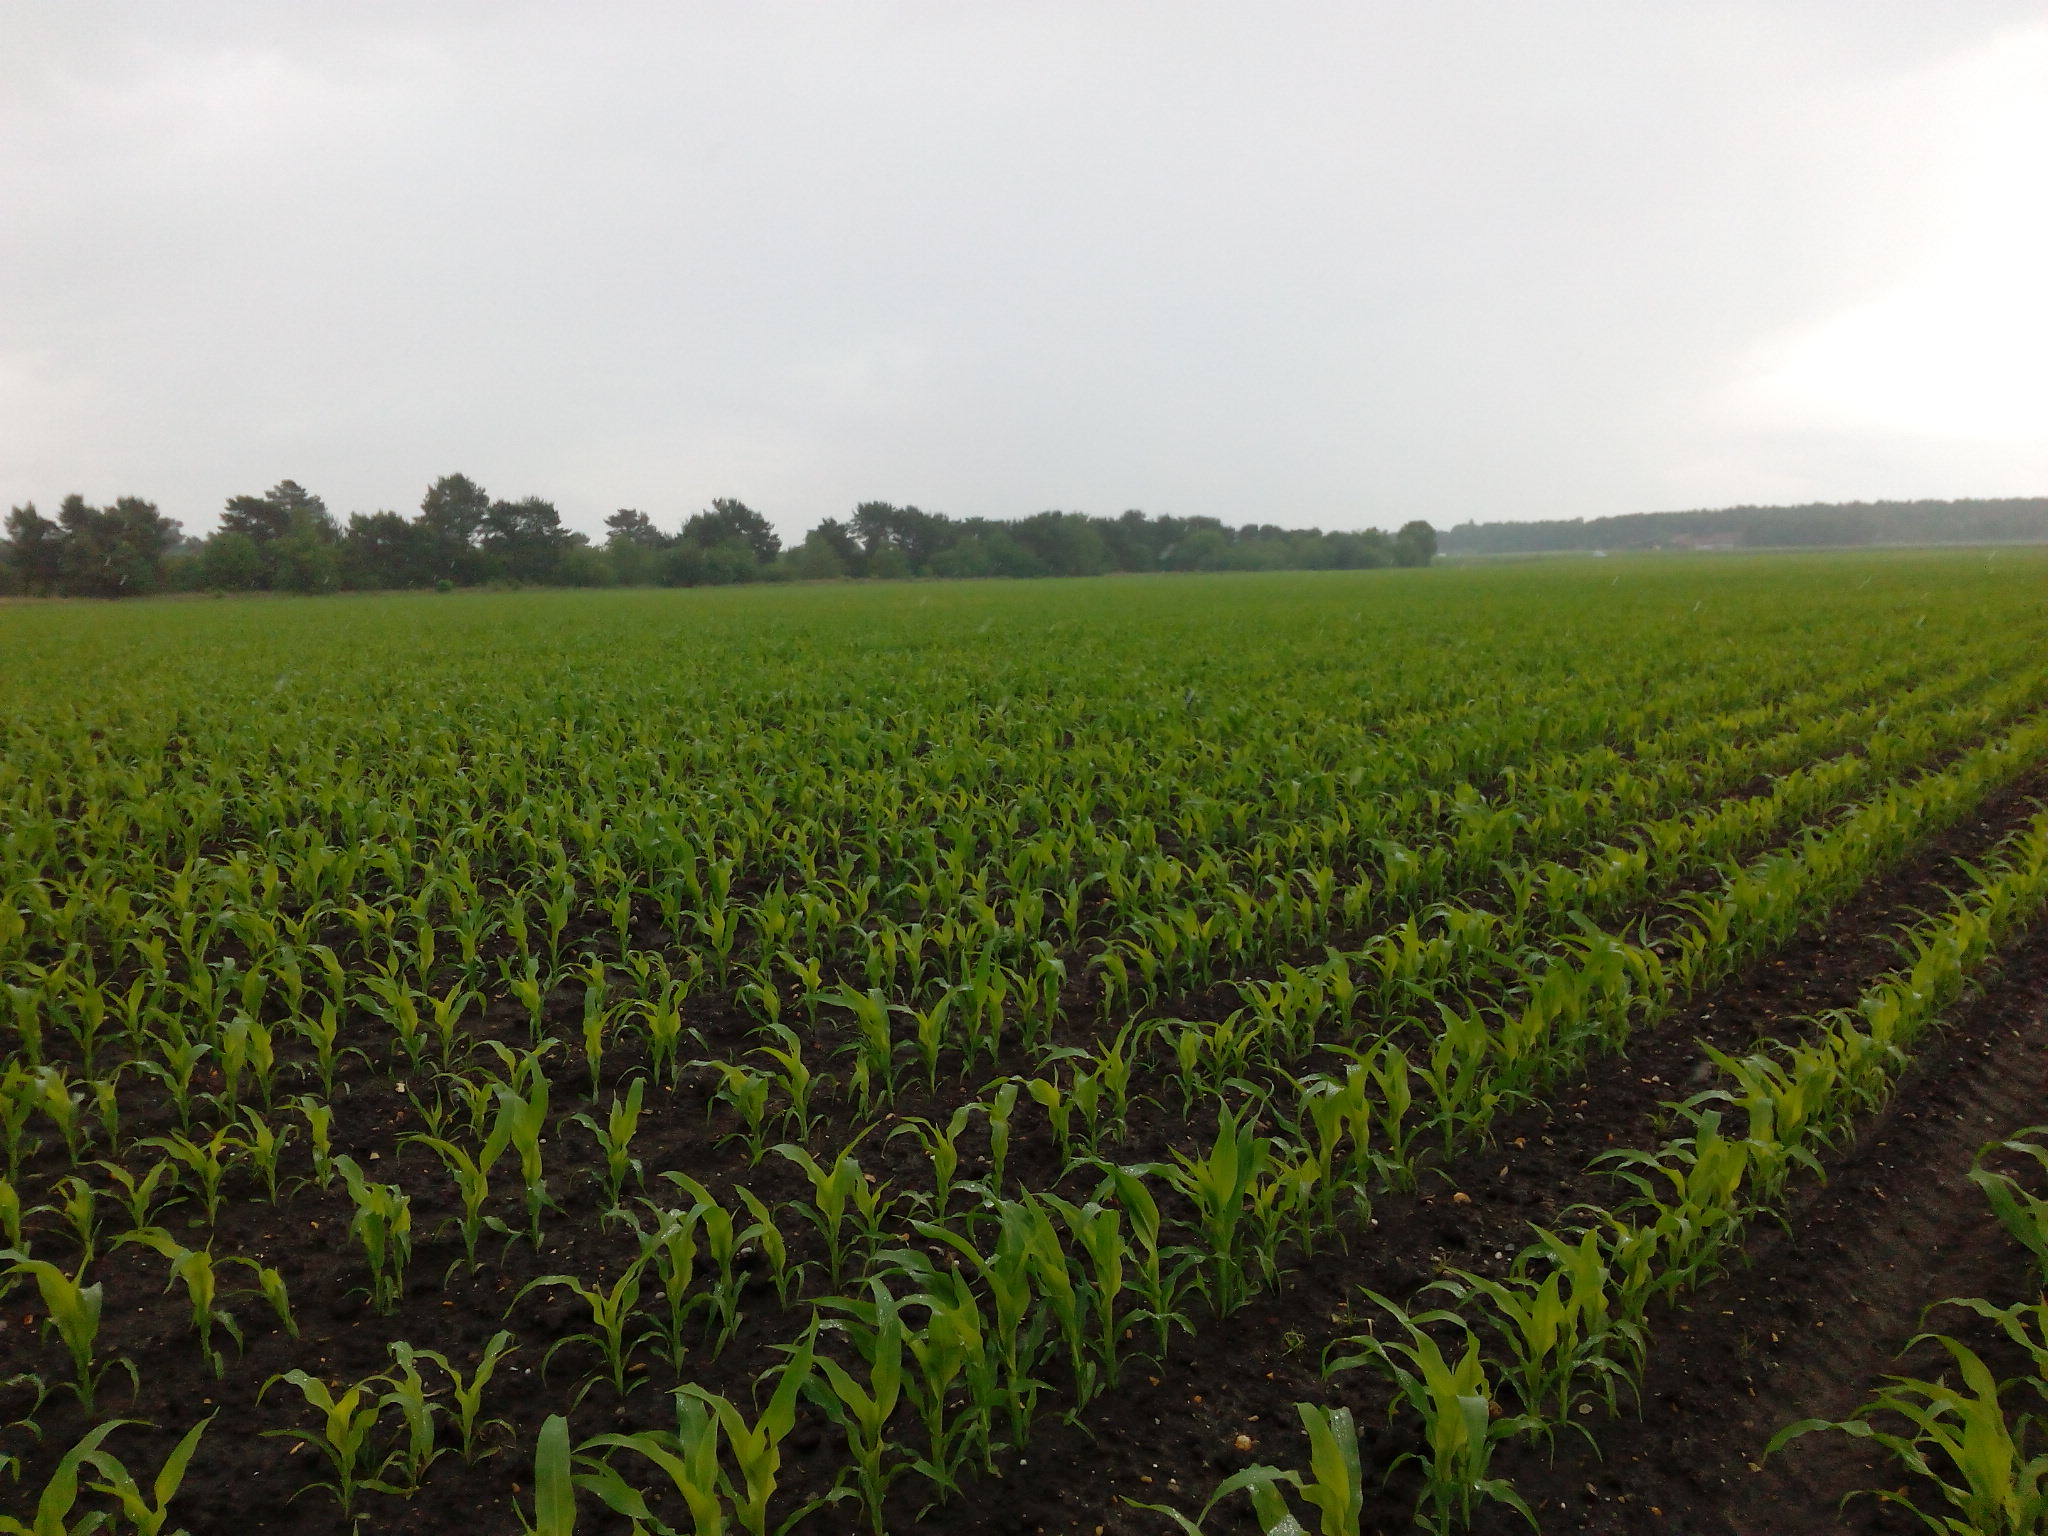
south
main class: Cropland
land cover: Maize
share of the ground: 50 - 75 %
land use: Agriculture (excluding fallow land and kitchen gardens)
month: June
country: DE
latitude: 52.8987
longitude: 9.9257
